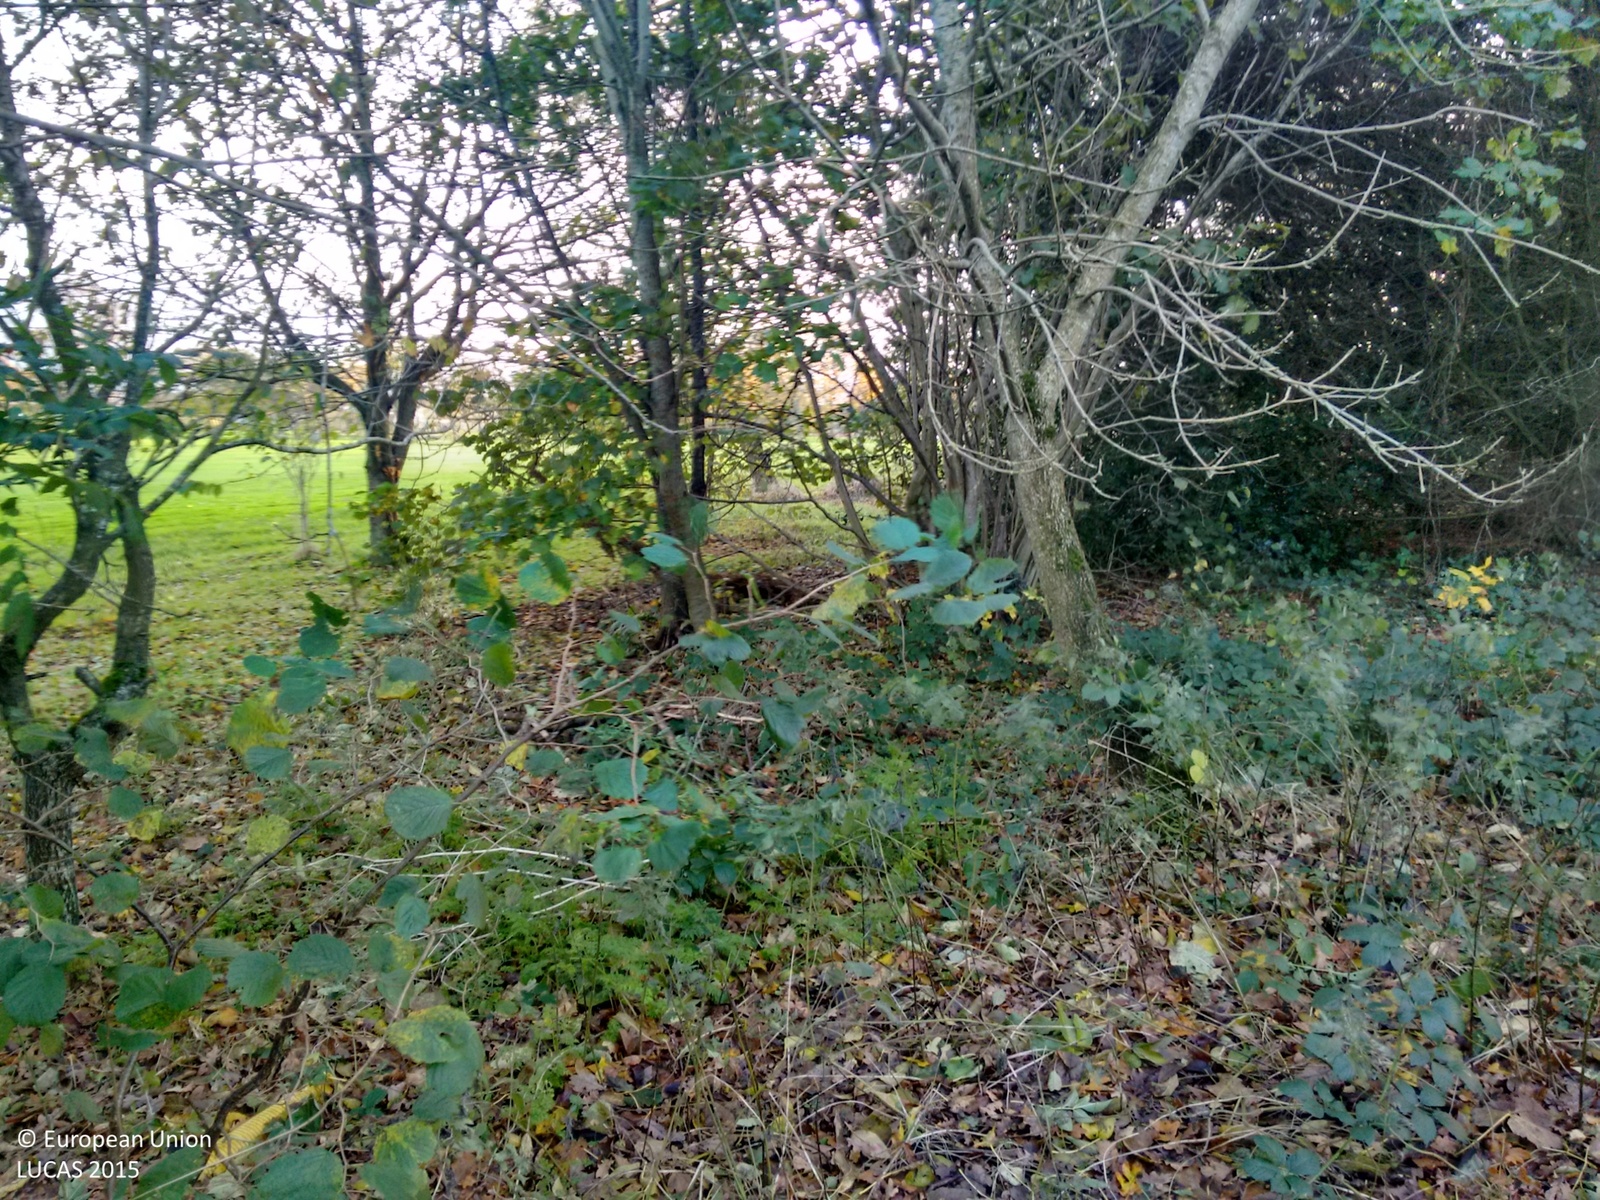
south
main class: Woodland
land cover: Broadleaved woodland
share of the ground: > 75 %
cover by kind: herbaceous plants 40 %, broadleaved forest trees 30 %
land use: Sport
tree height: > 5 m
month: November
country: GB
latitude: 54.6287
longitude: -5.9547
